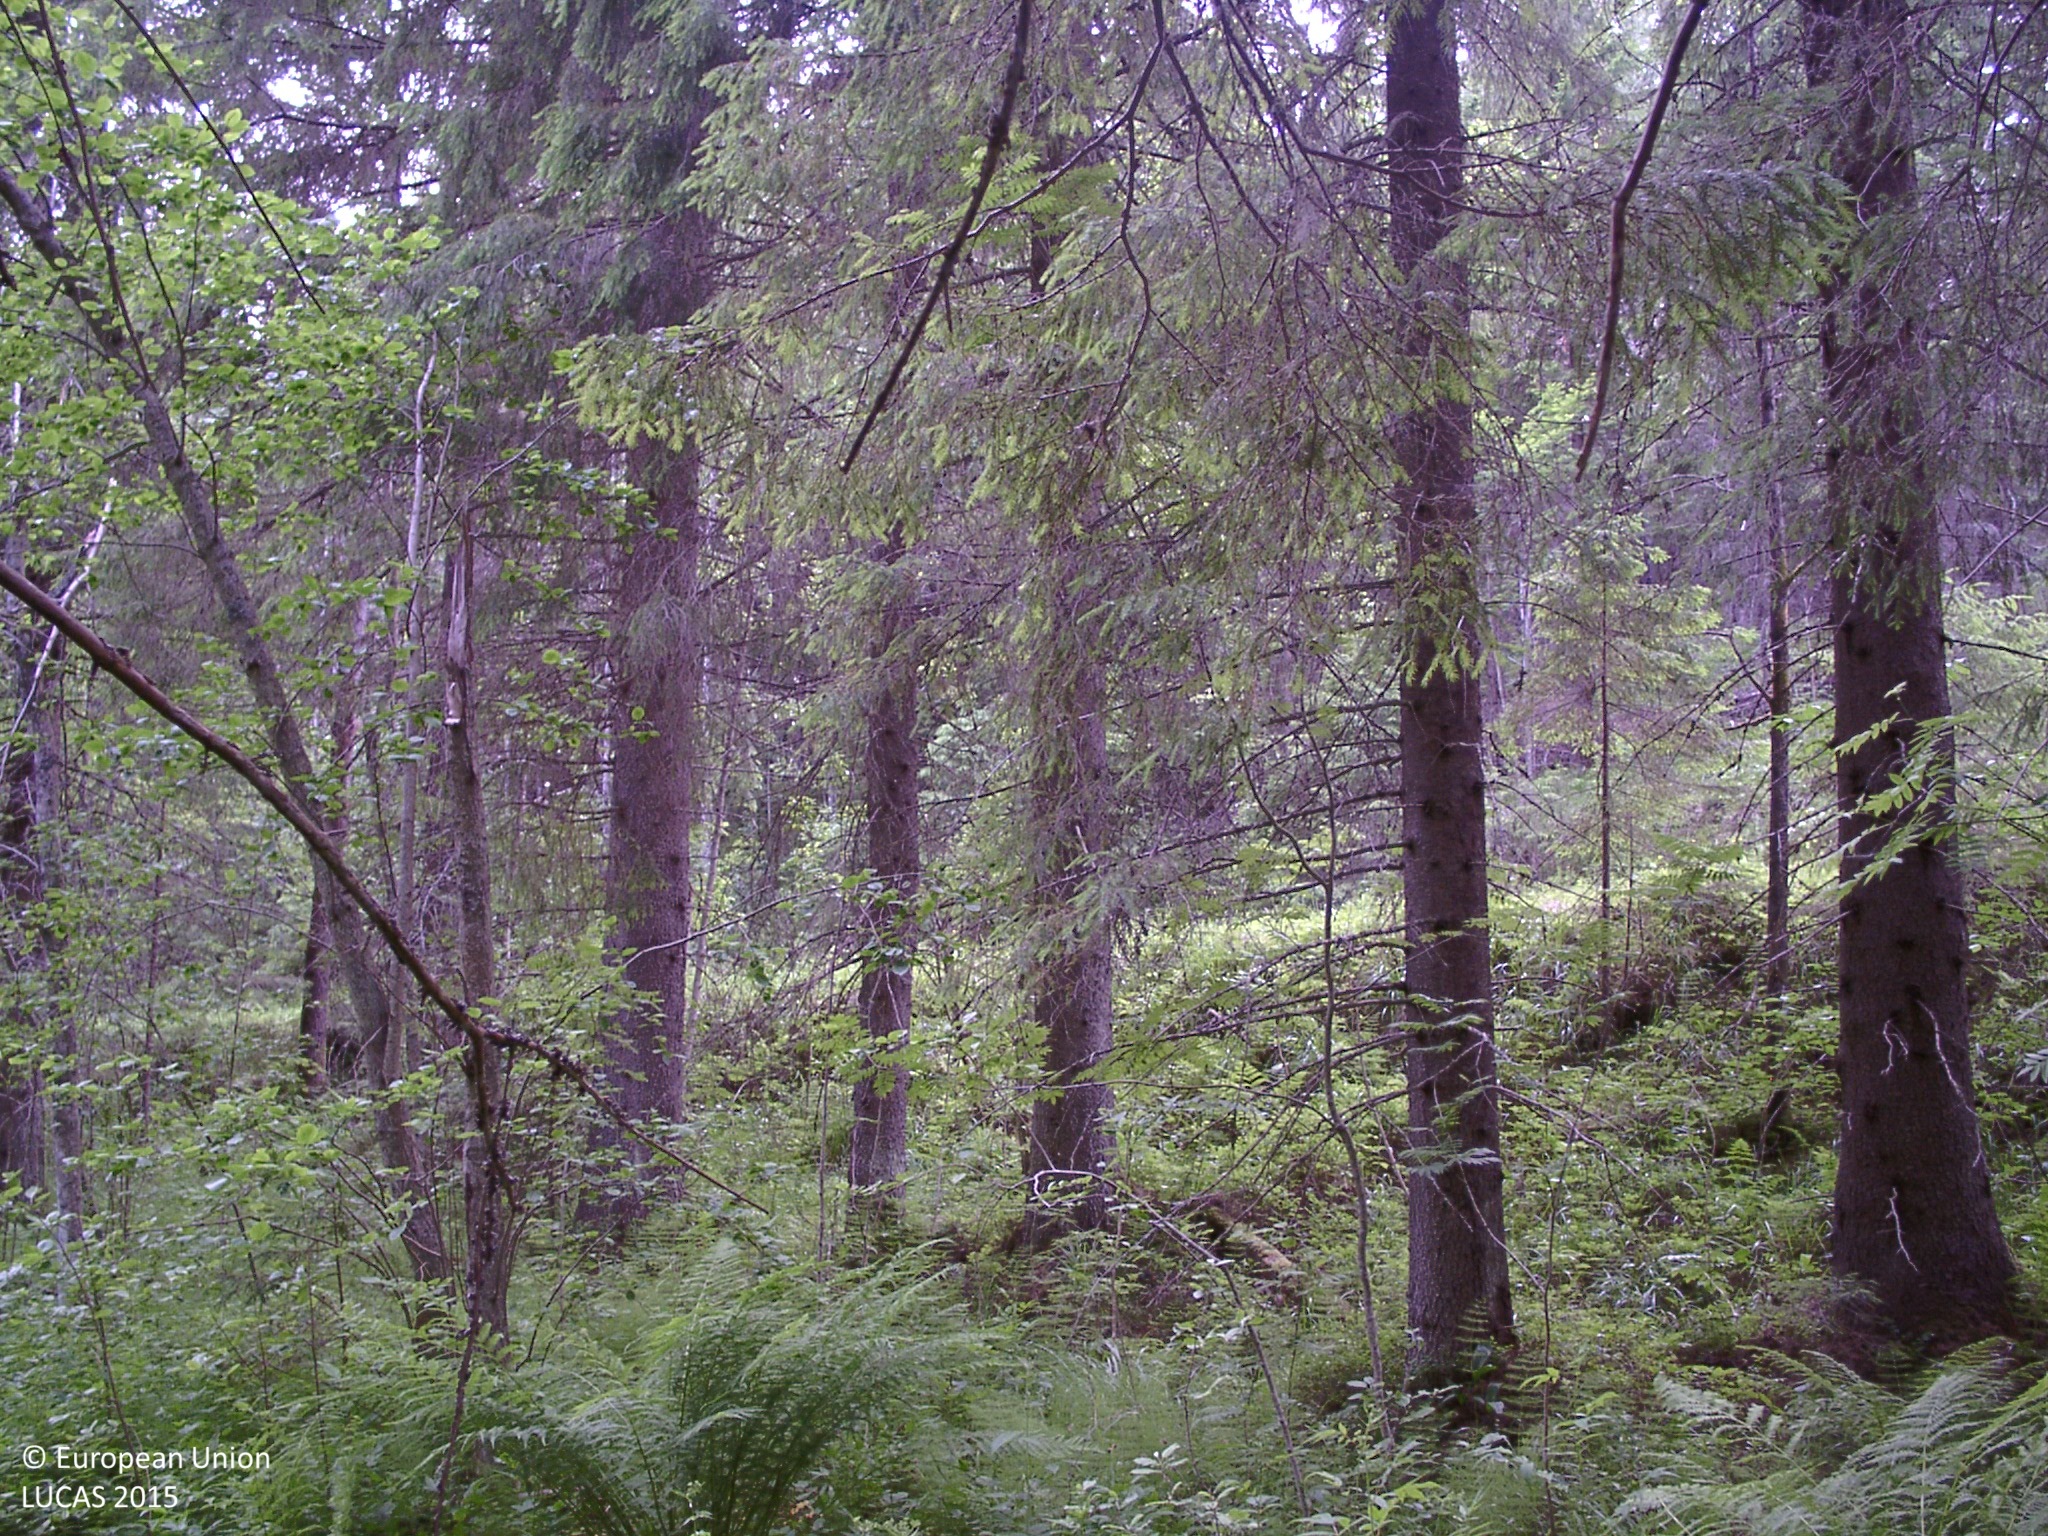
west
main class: Woodland
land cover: Spruce dominated mixed woodland
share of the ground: 50 - 75 %
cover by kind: coniferous forest trees 45 %, herbaceous plants 30 %, broadleaved forest trees 20 %, lichens and mosses 5 %
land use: Forestry
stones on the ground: < 10 %
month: July
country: FI
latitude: 62.0102
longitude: 25.4528
